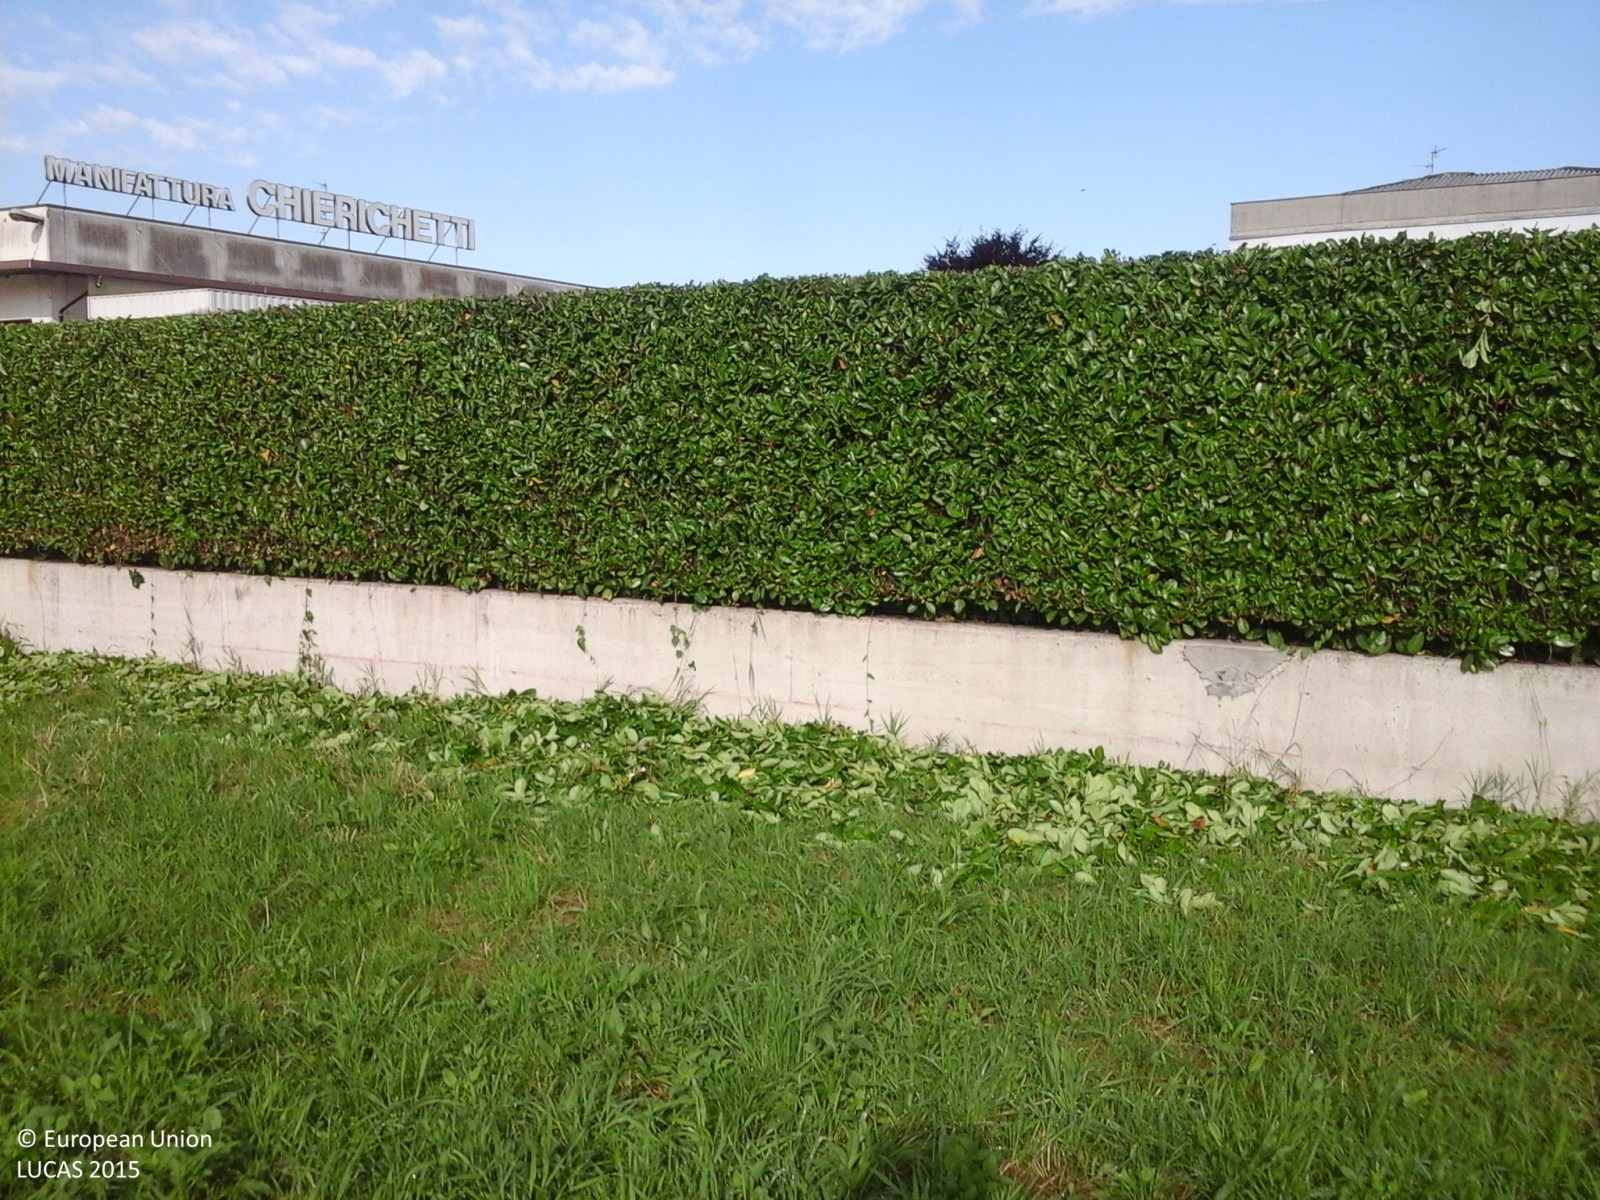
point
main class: Grassland
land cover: Grassland without tree/shrub cover
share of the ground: > 75 %
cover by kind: herbaceous plants 100 %
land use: Agriculture (excluding fallow land and kitchen gardens)
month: June
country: IT
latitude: 45.6416
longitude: 8.7831
